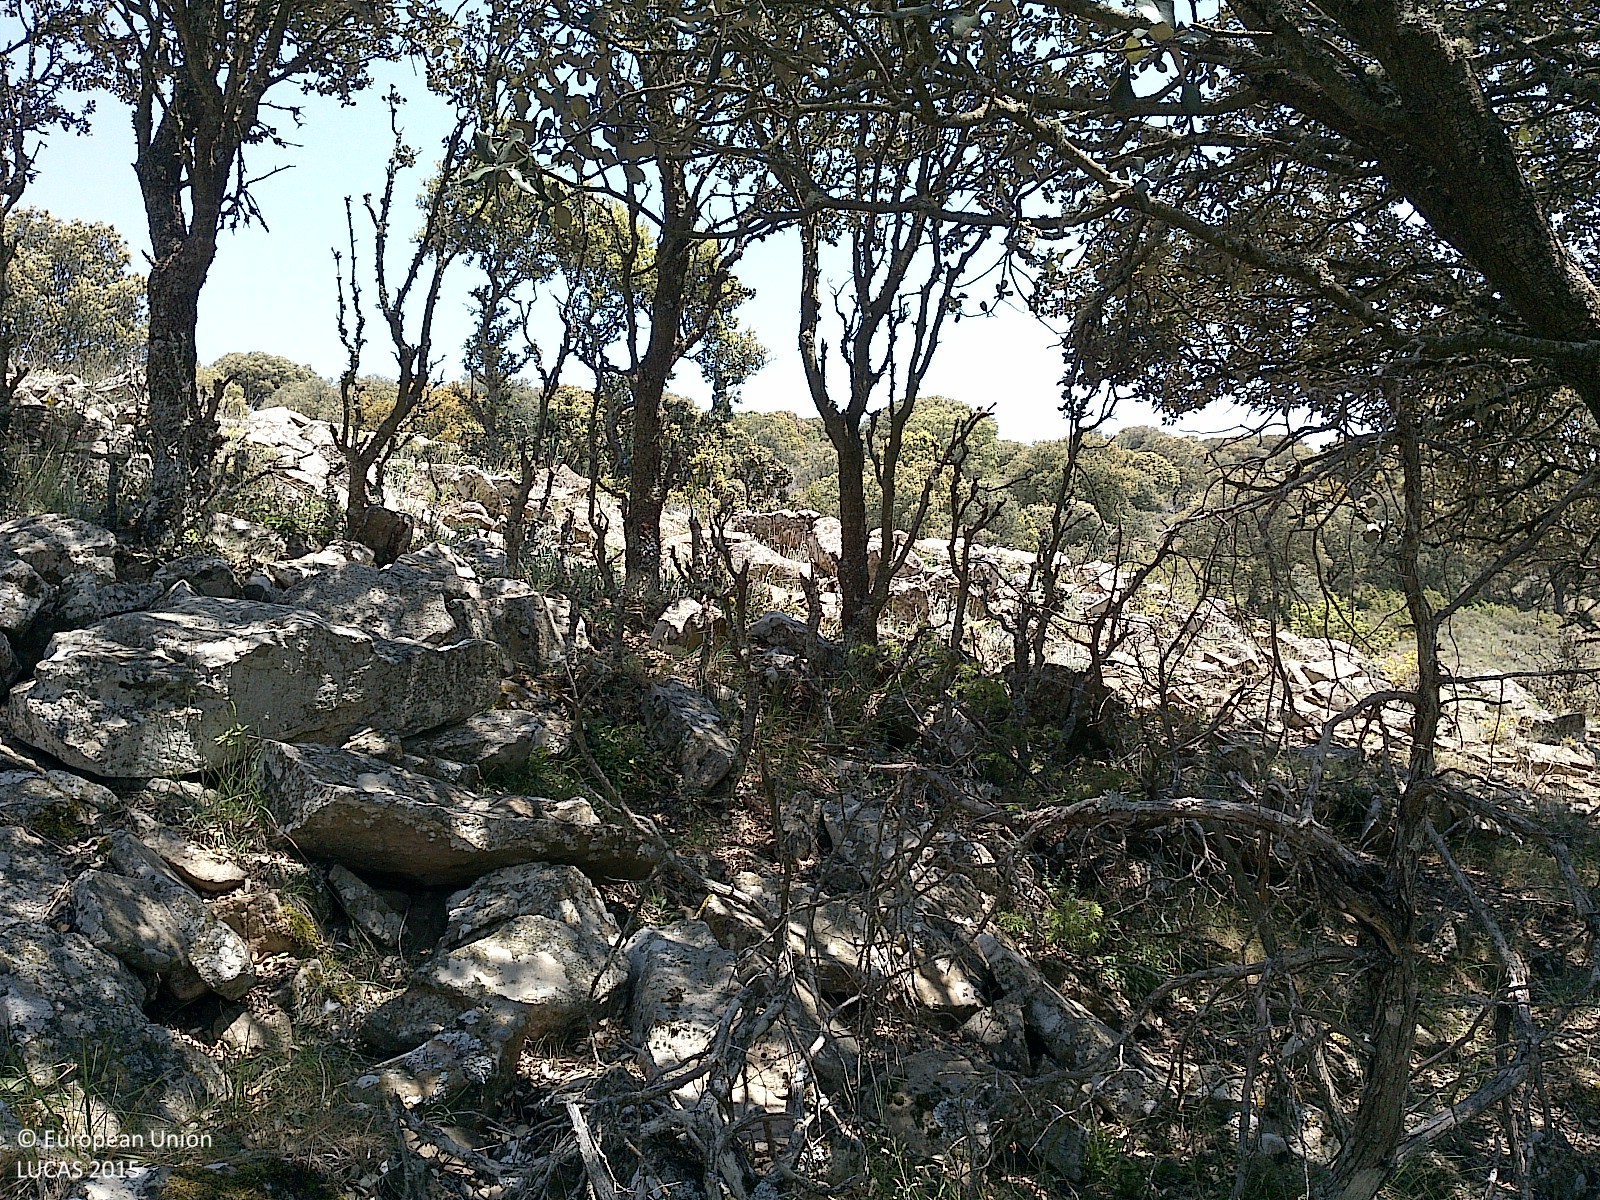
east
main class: Woodland
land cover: Broadleaved woodland
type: broadleaved evergreen forest
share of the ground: 25 - 50 %
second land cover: Grassland without tree/shrub cover
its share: 50 - 75 %
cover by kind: broadleaved forest trees 45 %, herbaceous plants 35 %, consolidated bare surface 15 %, shrubs 5 %
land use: Forestry
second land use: Agriculture (excluding fallow land and kitchen gardens)
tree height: < 5 m
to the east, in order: Broadleaved woodland; Grassland without tree/shrub cover; Rock outcrops; Shrubland with sparse tree cover; Broadleaved woodland; Shrubland with sparse tree cover; Broadleaved woodland; Barley; Broadleaved woodland
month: May
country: ES
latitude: 41.8571
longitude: -2.2145
